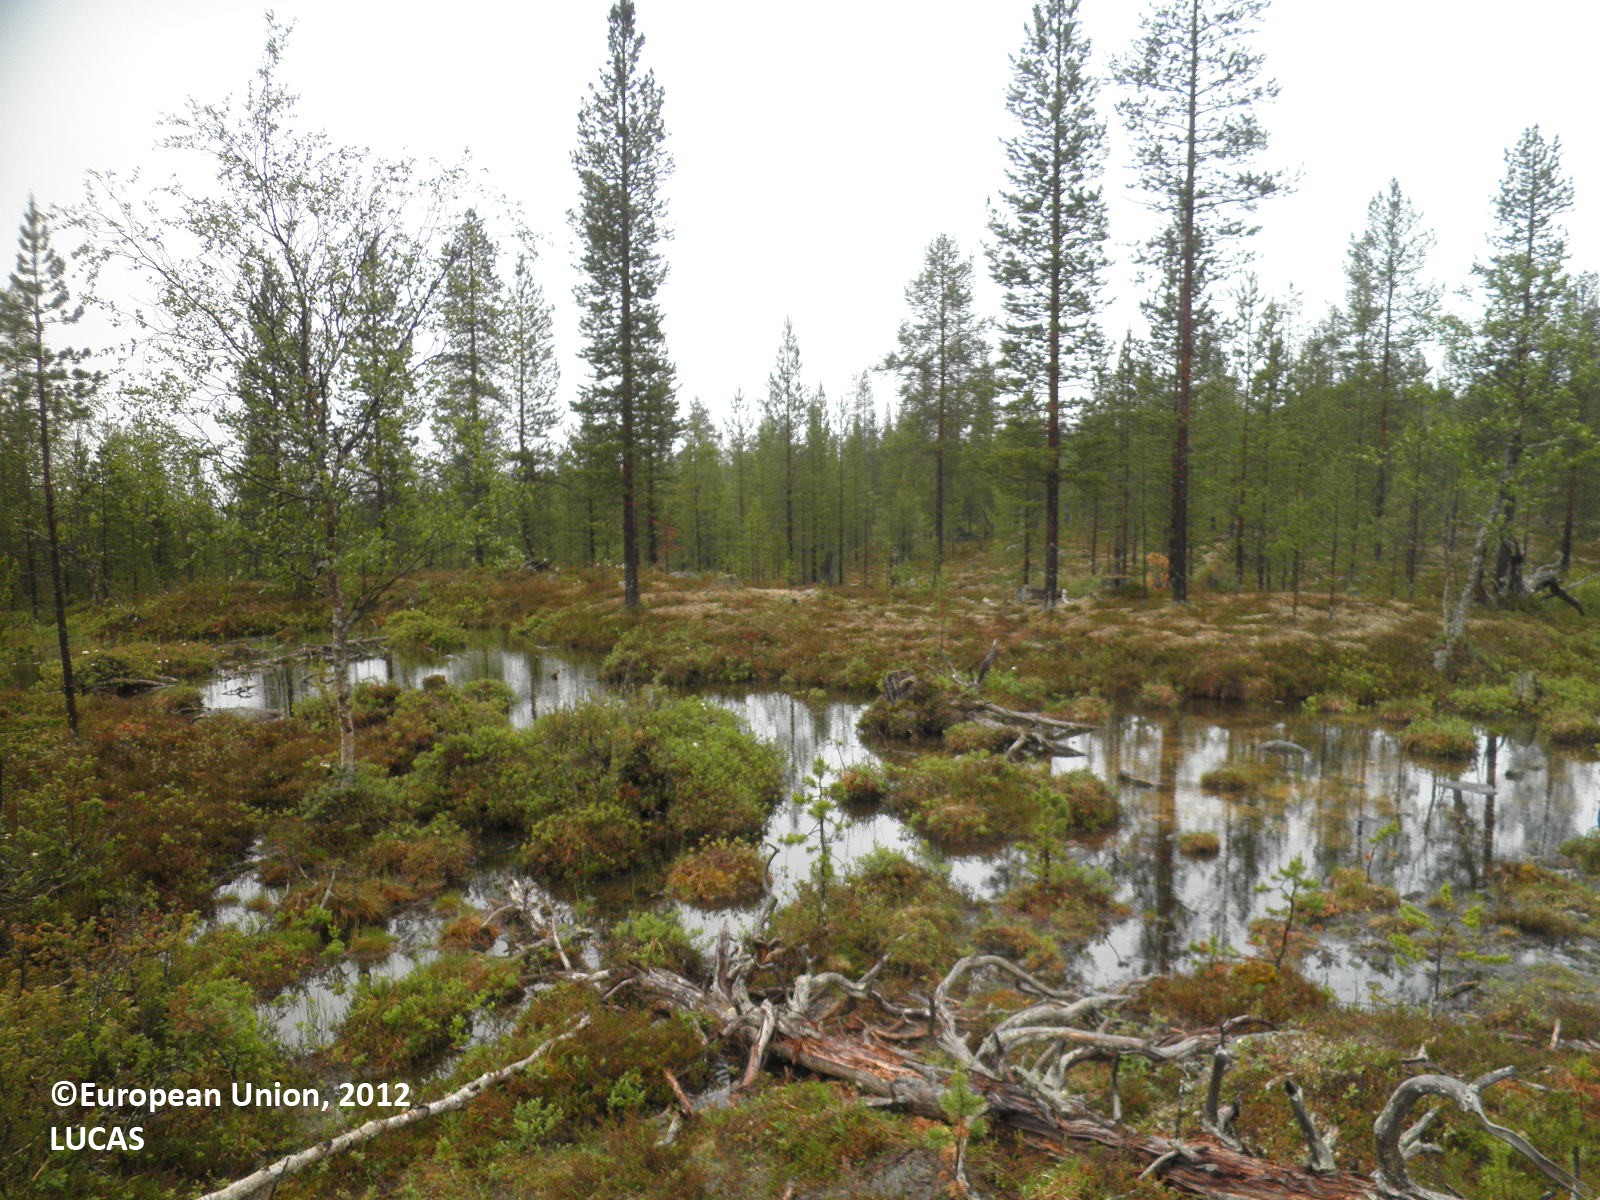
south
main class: Woodland
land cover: Pine dominated coniferous woodland
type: boreal forest
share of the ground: 25 - 50 %
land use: Forestry
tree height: > 5 m
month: June
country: FI
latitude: 68.4796
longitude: 27.7986
